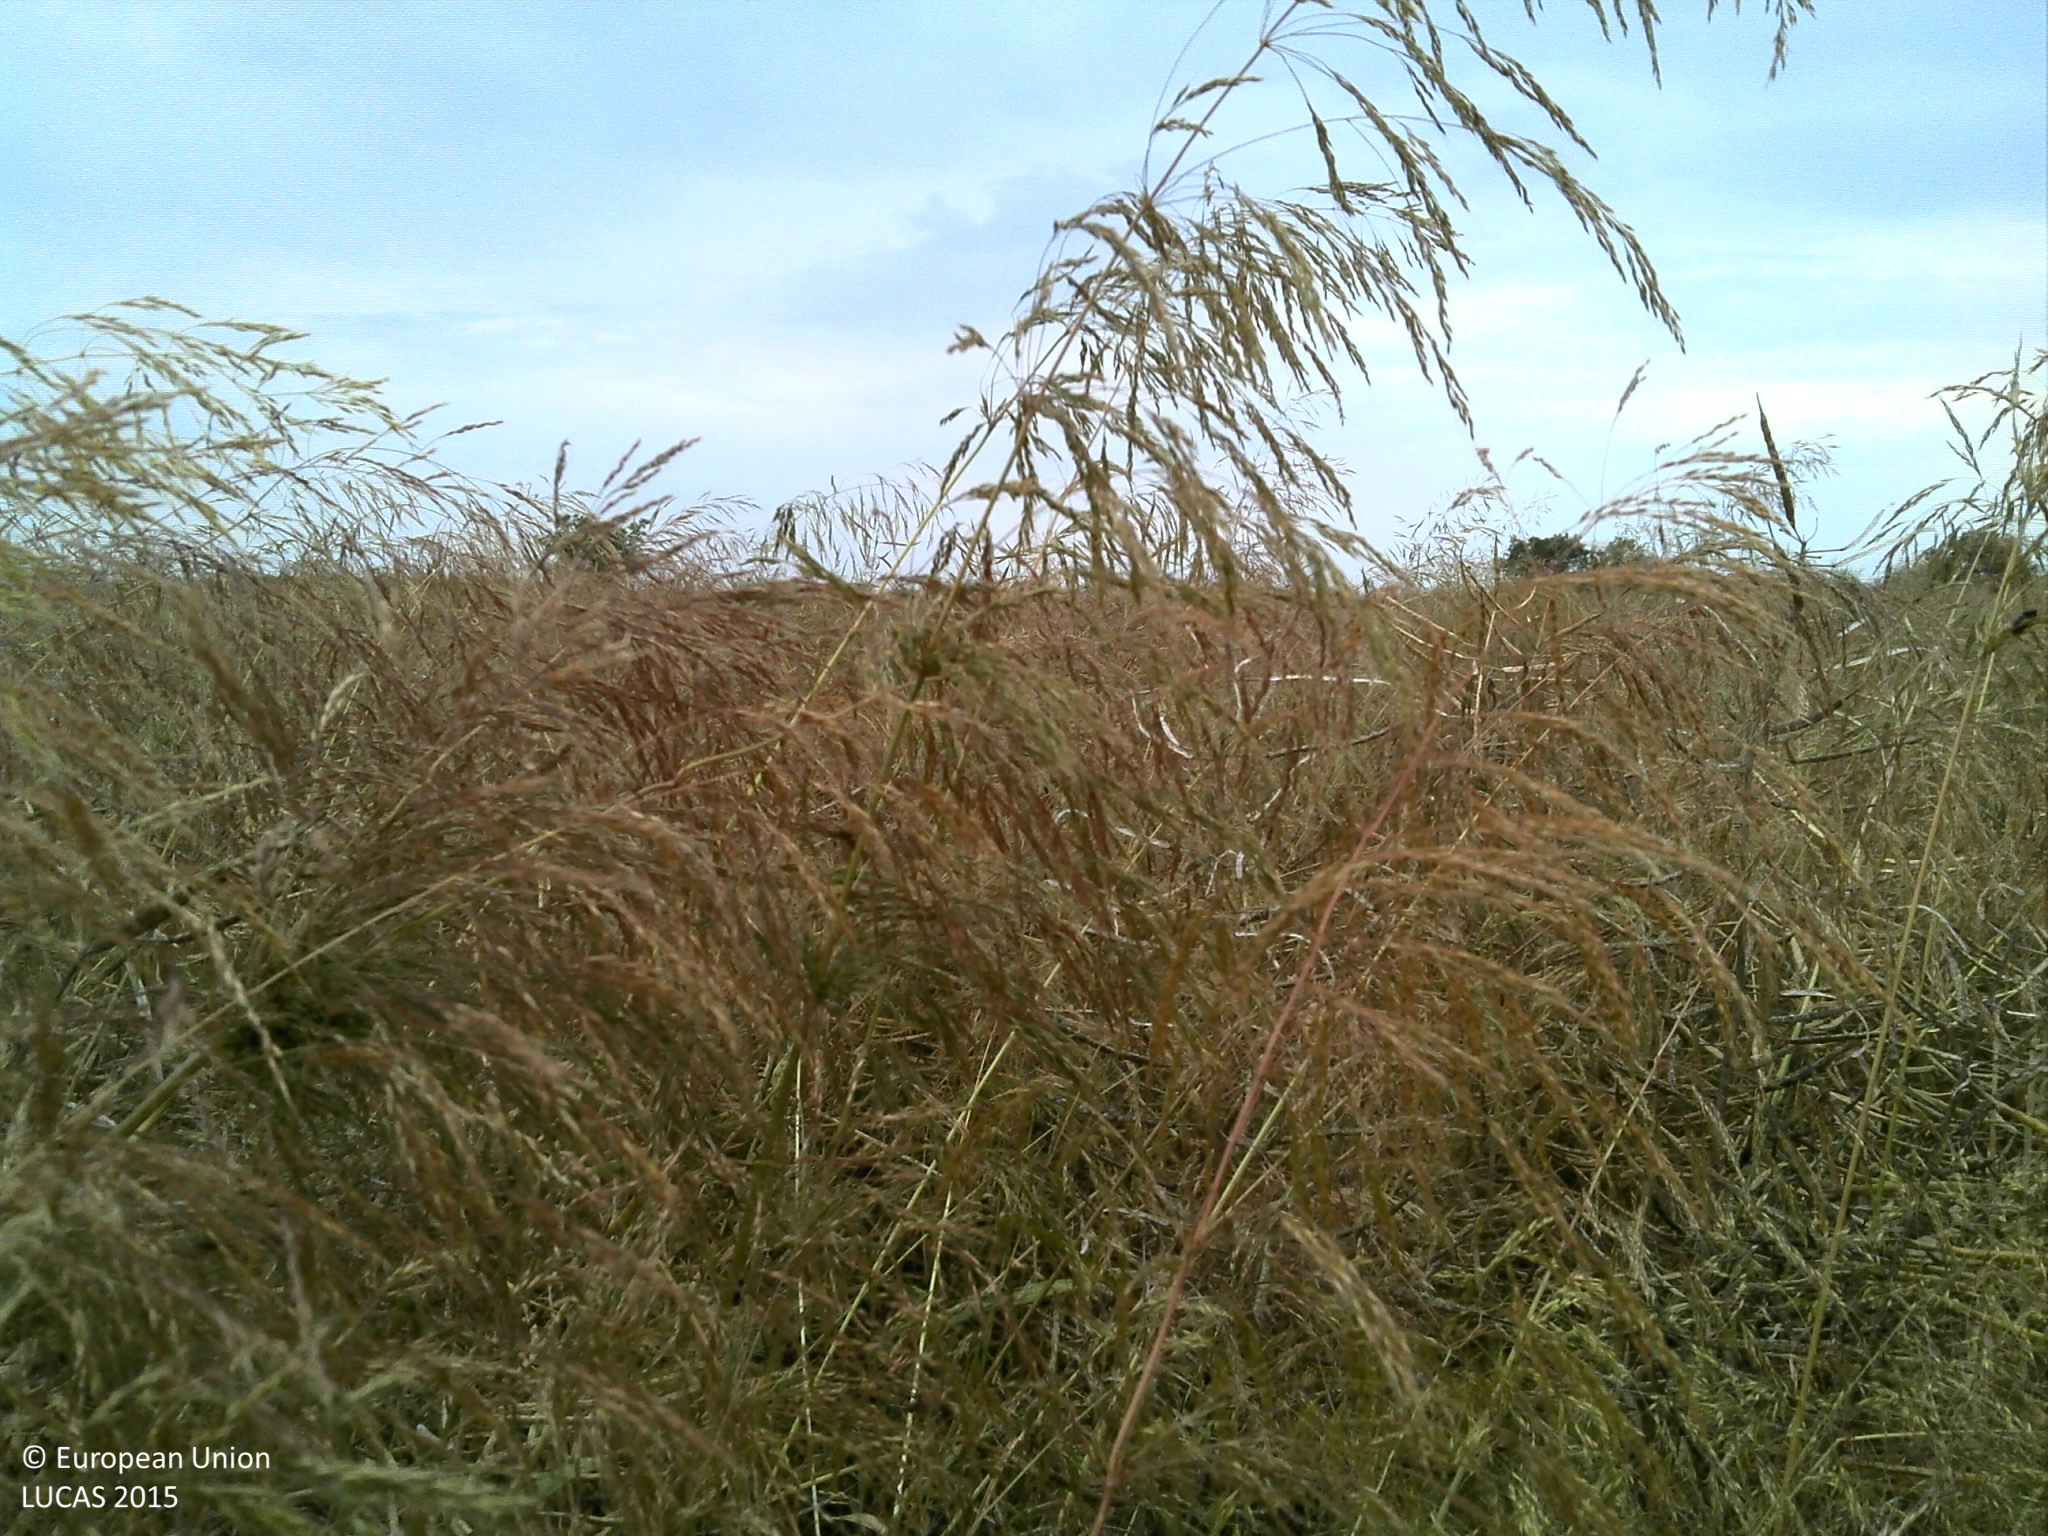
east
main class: Cropland
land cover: Rape and turnip rape
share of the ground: > 75 %
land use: Agriculture (excluding fallow land and kitchen gardens)
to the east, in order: Rape and turnip rape; Ditches and canals; Sunflower; Tracks; Sunflower; Common wheat; Sunflower; Common wheat; Rape and turnip rape
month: June
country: HR
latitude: 45.3470
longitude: 18.4418
